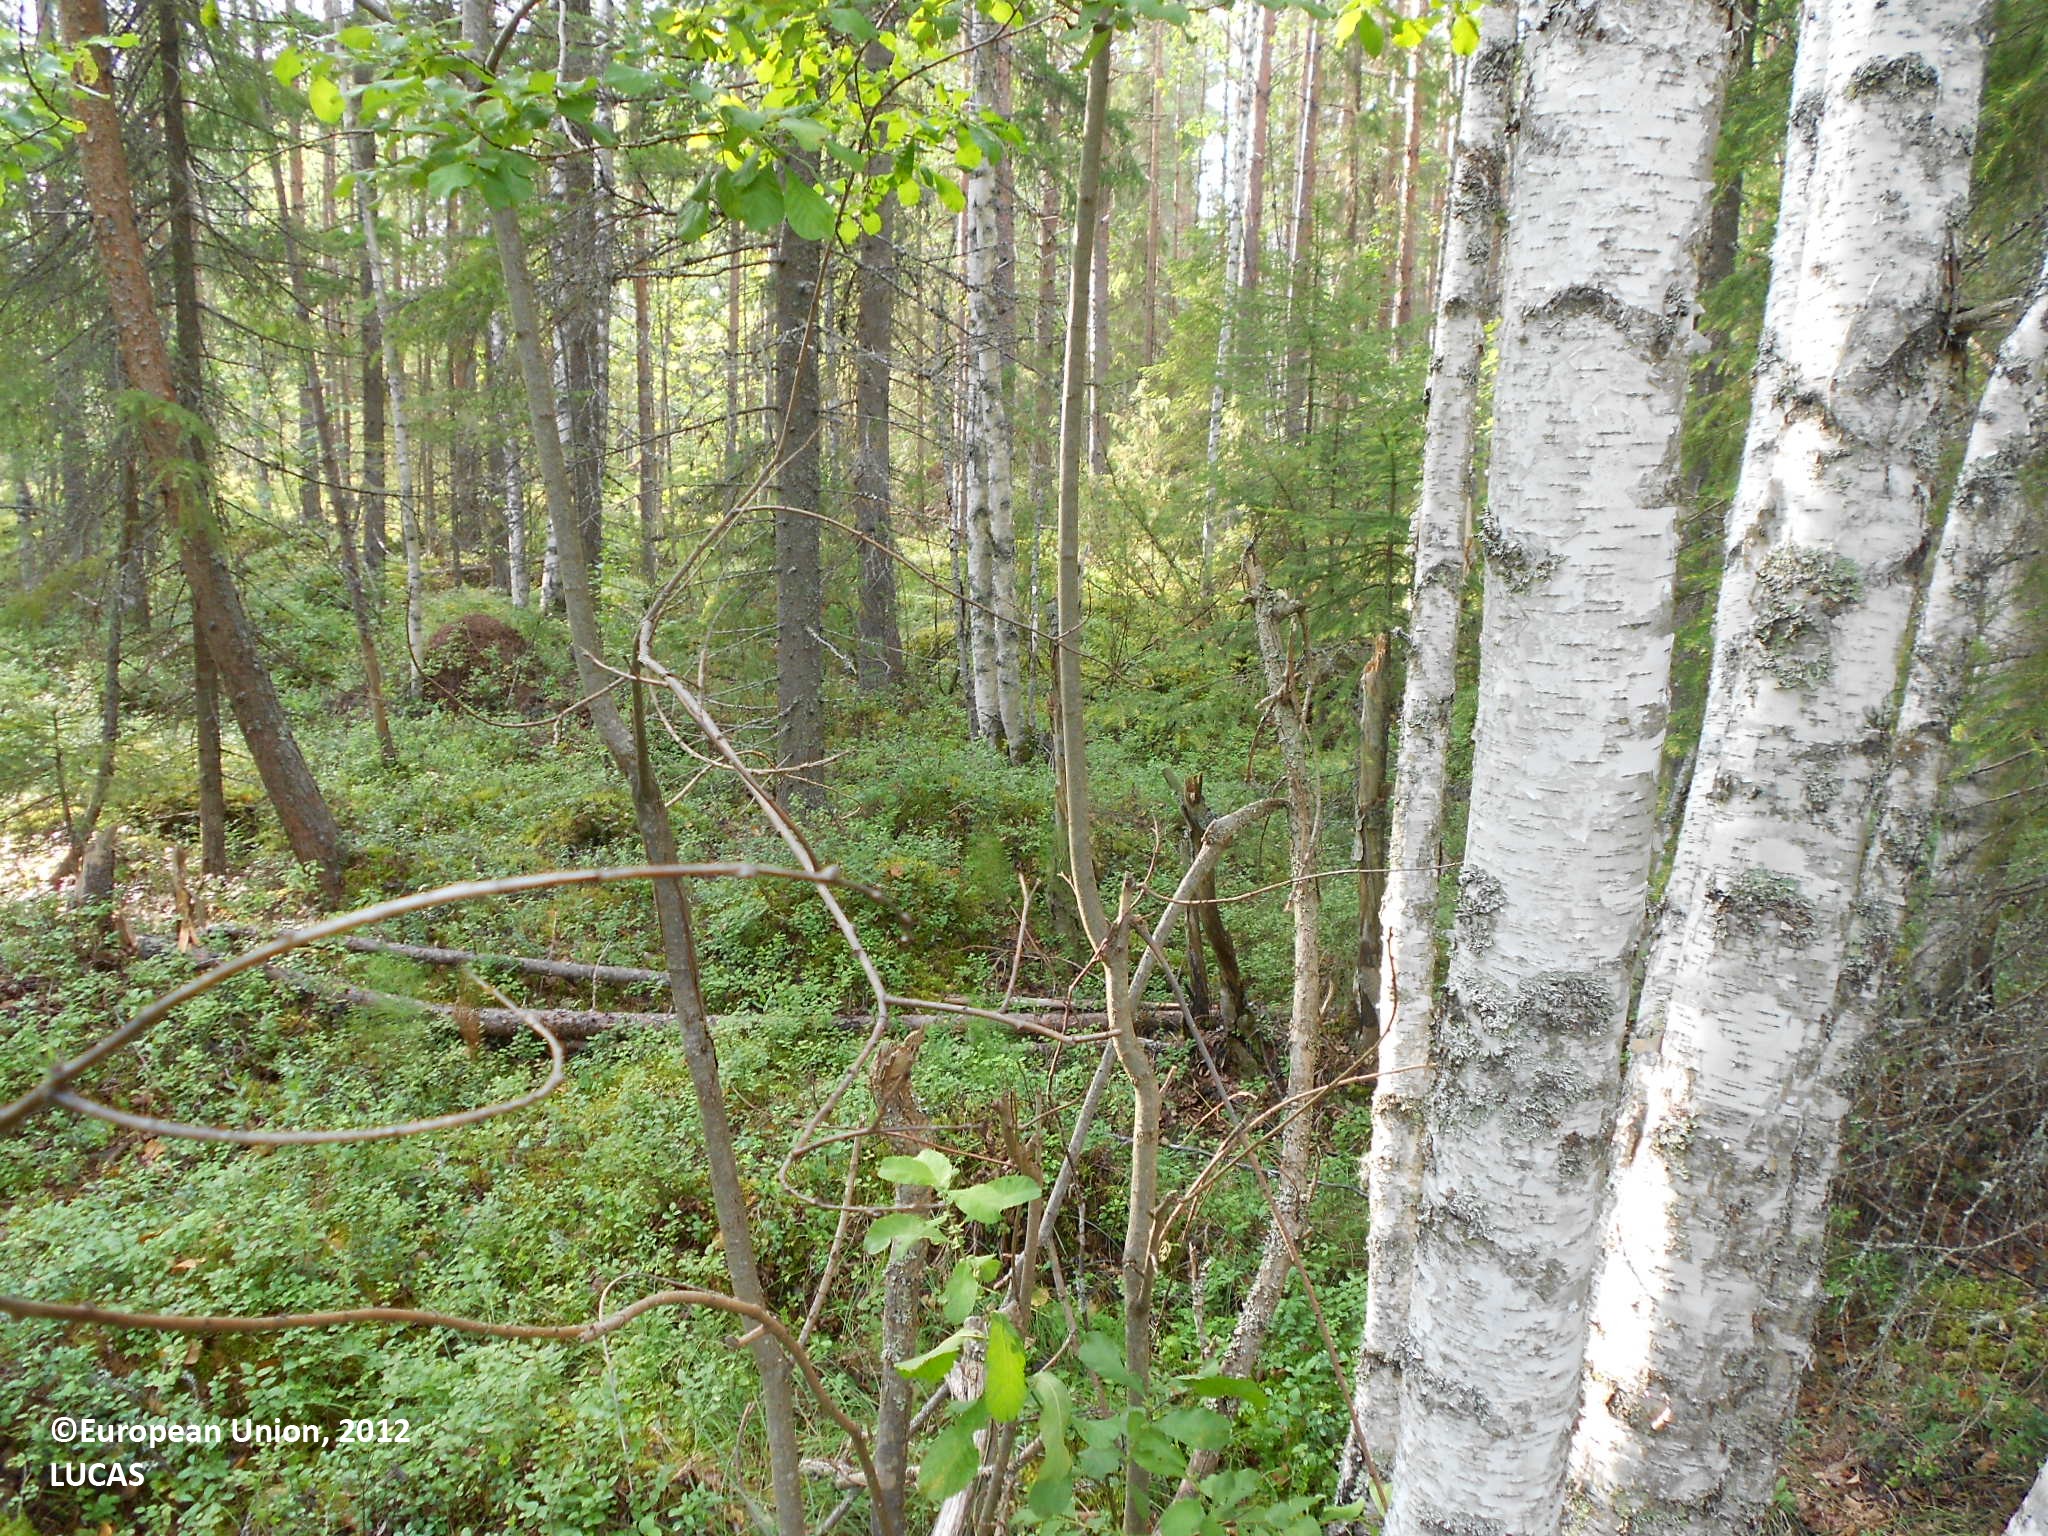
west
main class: Woodland
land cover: Pine dominated coniferous woodland
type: boreal forest
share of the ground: 50 - 75 %
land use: Forestry
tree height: > 5 m
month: August
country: FI
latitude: 63.3724
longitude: 29.0708
